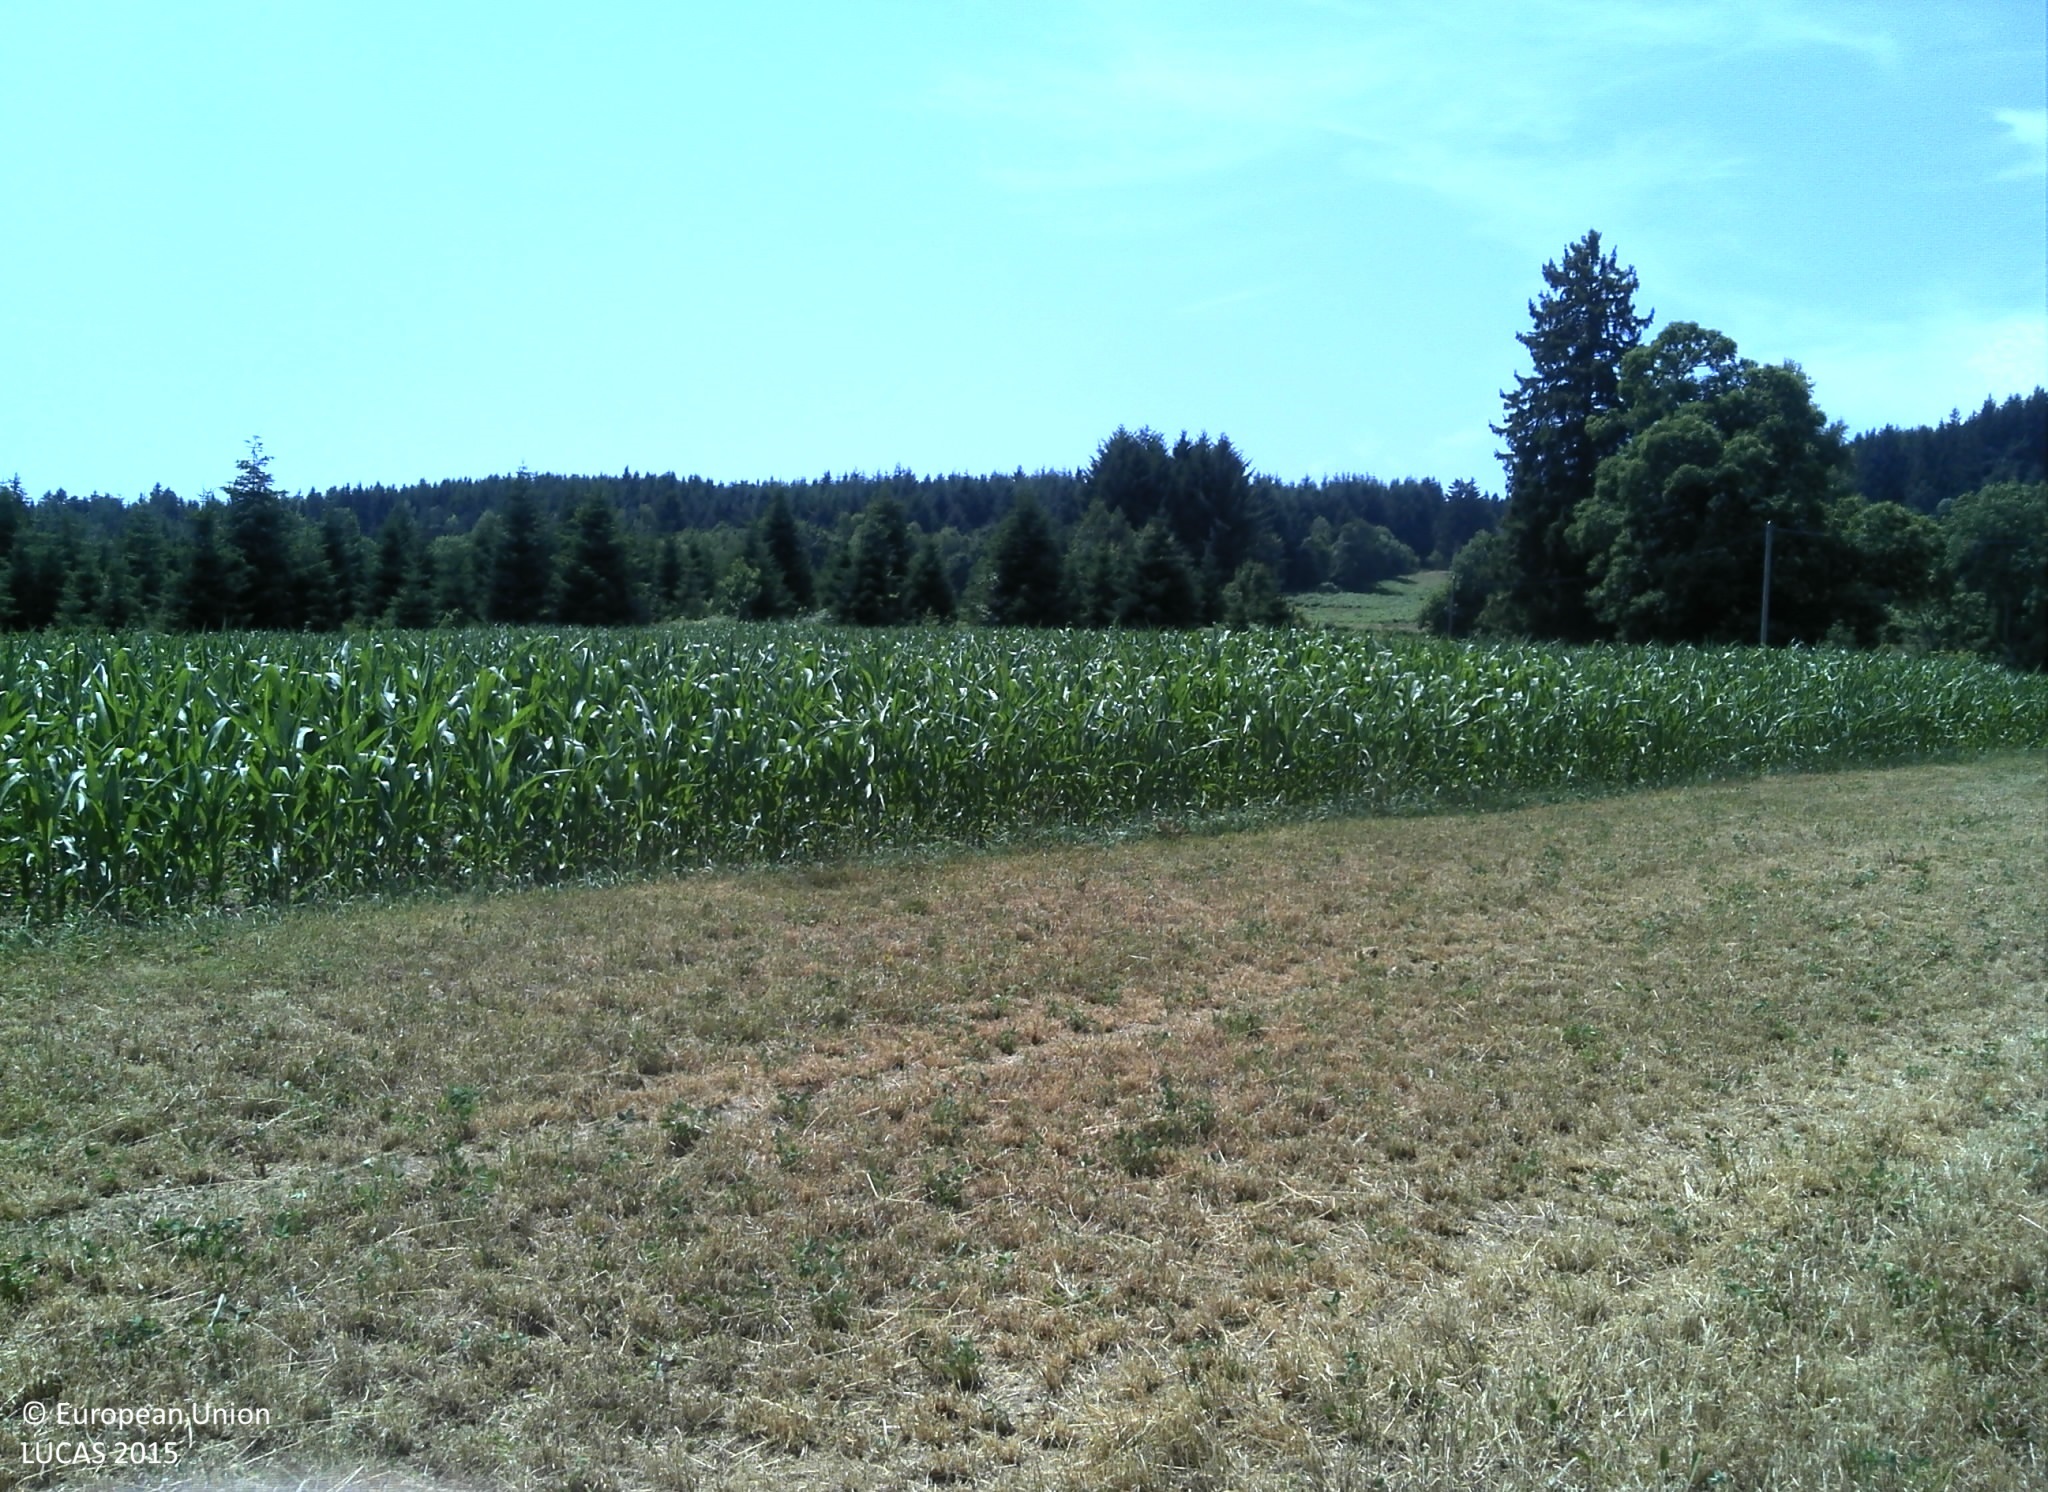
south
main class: Cropland
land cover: Temporary grasslands
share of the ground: > 75 %
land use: Agriculture (excluding fallow land and kitchen gardens)
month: July
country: FR
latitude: 45.8062
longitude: 3.7350
